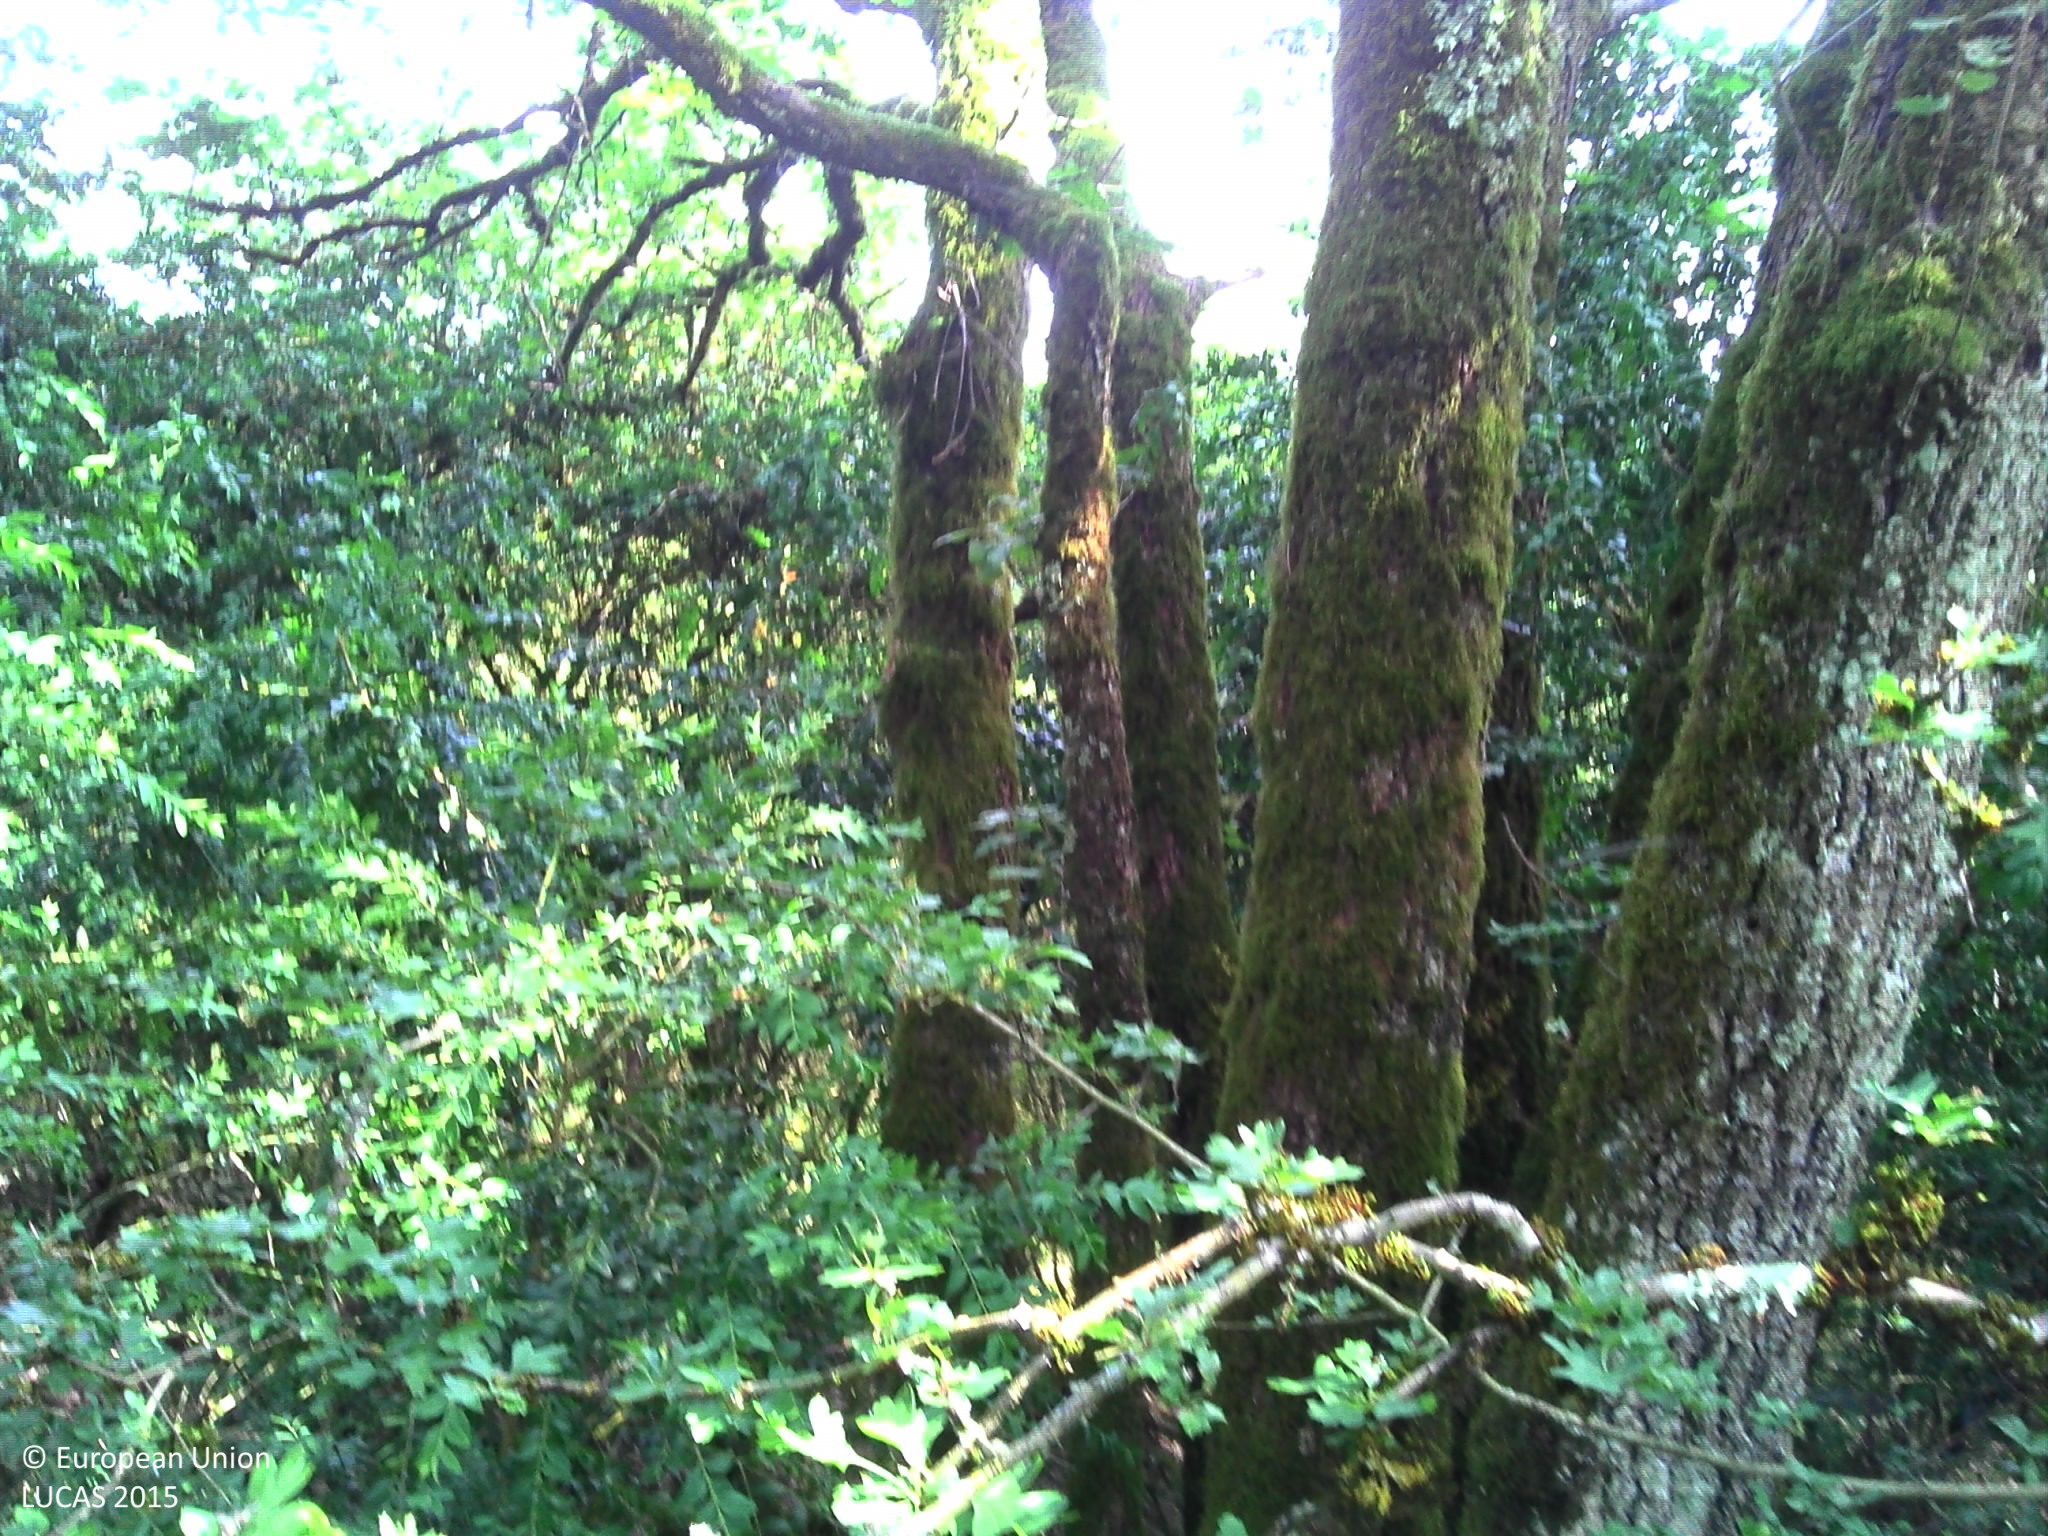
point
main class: Woodland
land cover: Pine dominated mixed woodland
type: hemiboreal forest and nemoral coniferous forest and mixed broadleaved-coniferous forest
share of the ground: > 75 %
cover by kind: coniferous forest trees 50 %, broadleaved forest trees 25 %, shrubs 10 %, lichens and mosses 10 %, herbaceous plants 5 %
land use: Forestry
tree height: > 5 m
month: June
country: FR
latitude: 47.0561
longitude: 4.8269
